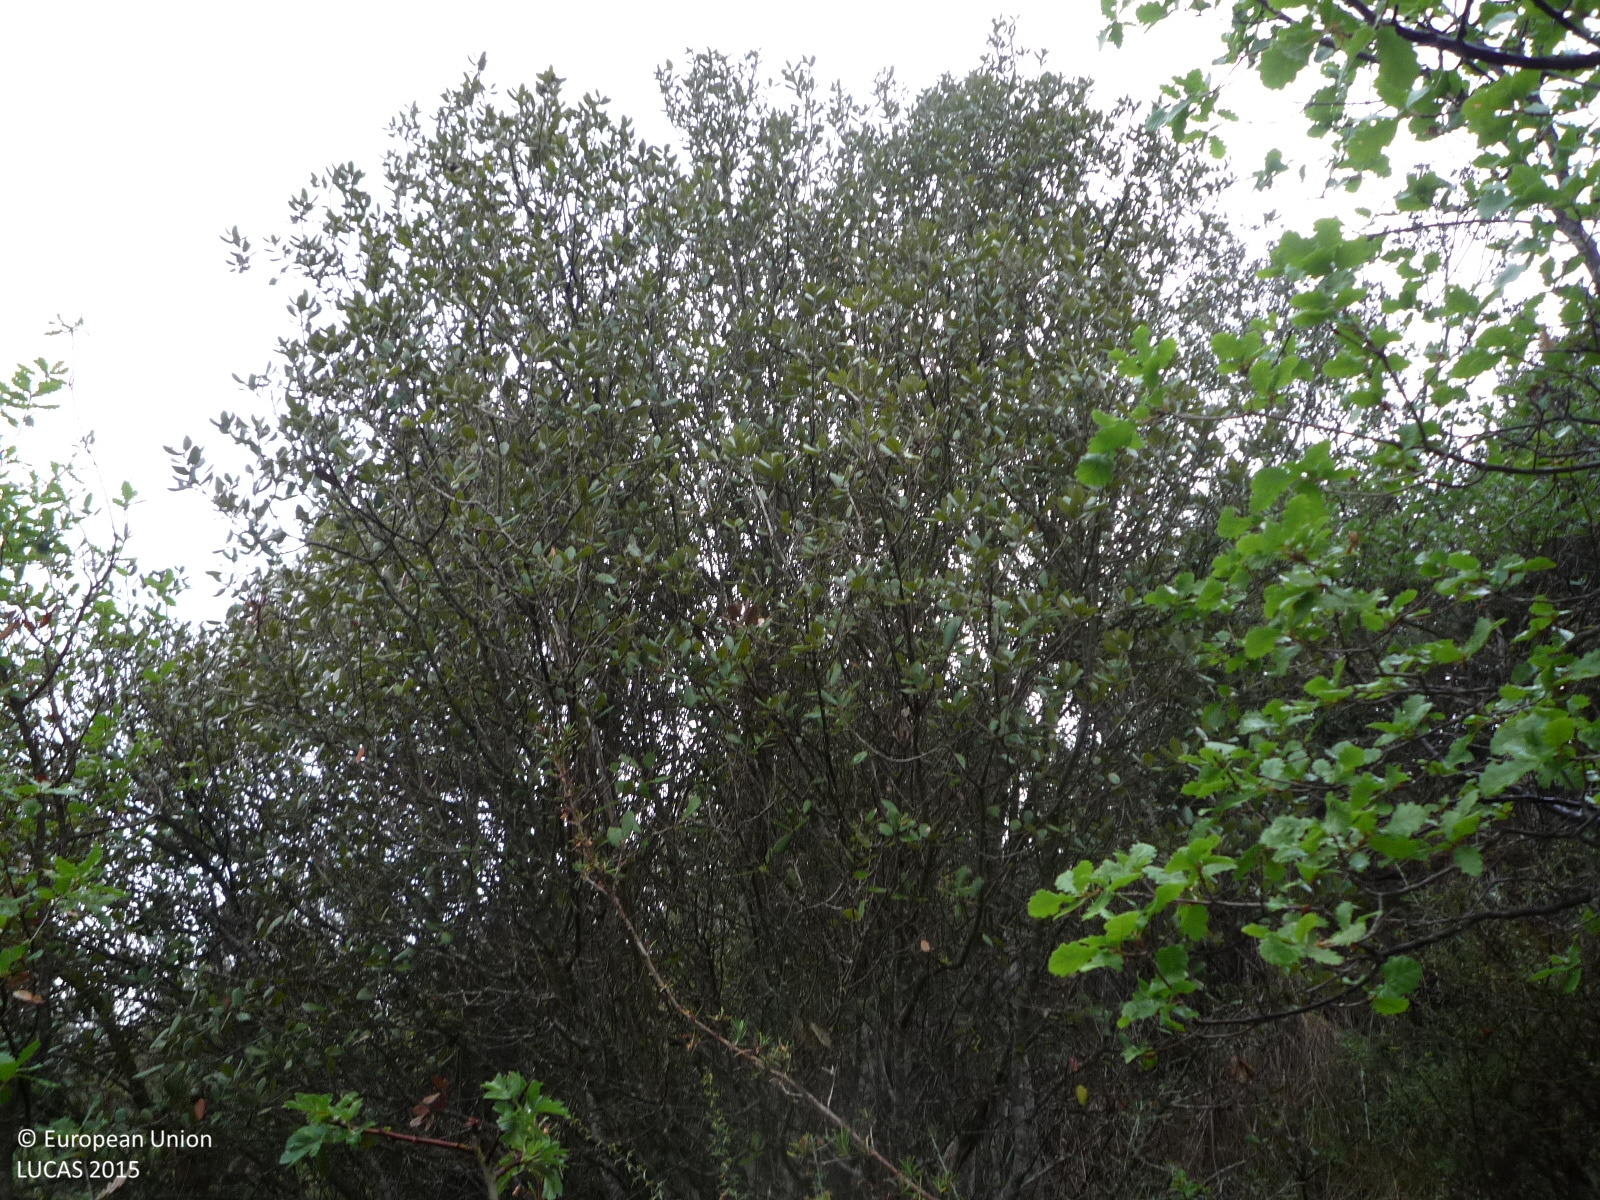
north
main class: Woodland
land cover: Broadleaved woodland
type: broadleaved evergreen forest
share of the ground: > 75 %
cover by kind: broadleaved forest trees 80 %, herbaceous plants 20 %
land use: Forestry
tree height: < 5 m
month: June
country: ES
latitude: 42.0594
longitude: 1.9291
